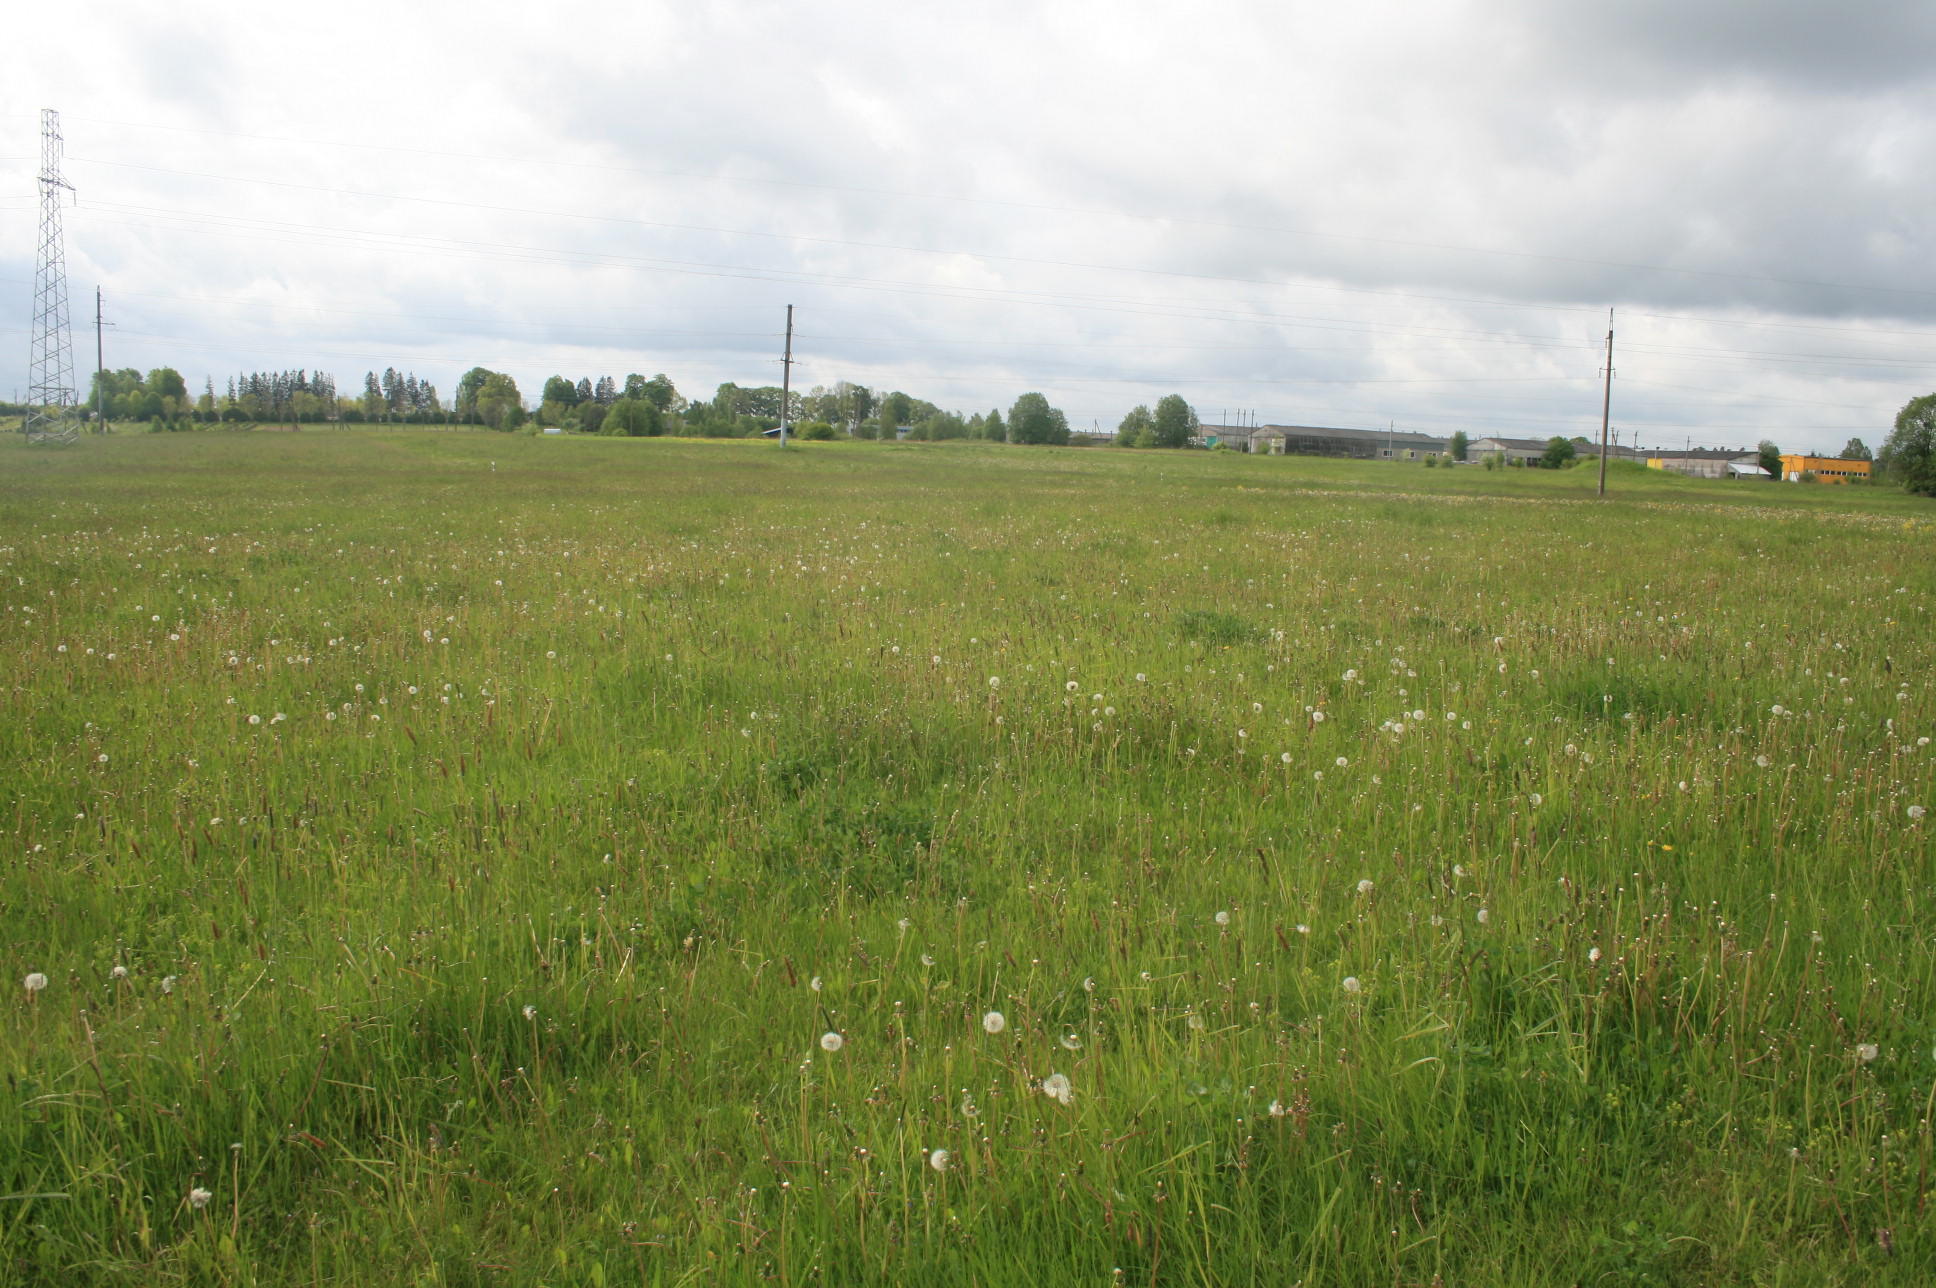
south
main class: Grassland
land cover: Grassland without tree/shrub cover
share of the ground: > 75 %
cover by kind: herbaceous plants 100 %
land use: Agriculture (excluding fallow land and kitchen gardens)
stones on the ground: < 10 %
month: May
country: LT
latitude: 55.7392
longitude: 21.9170
